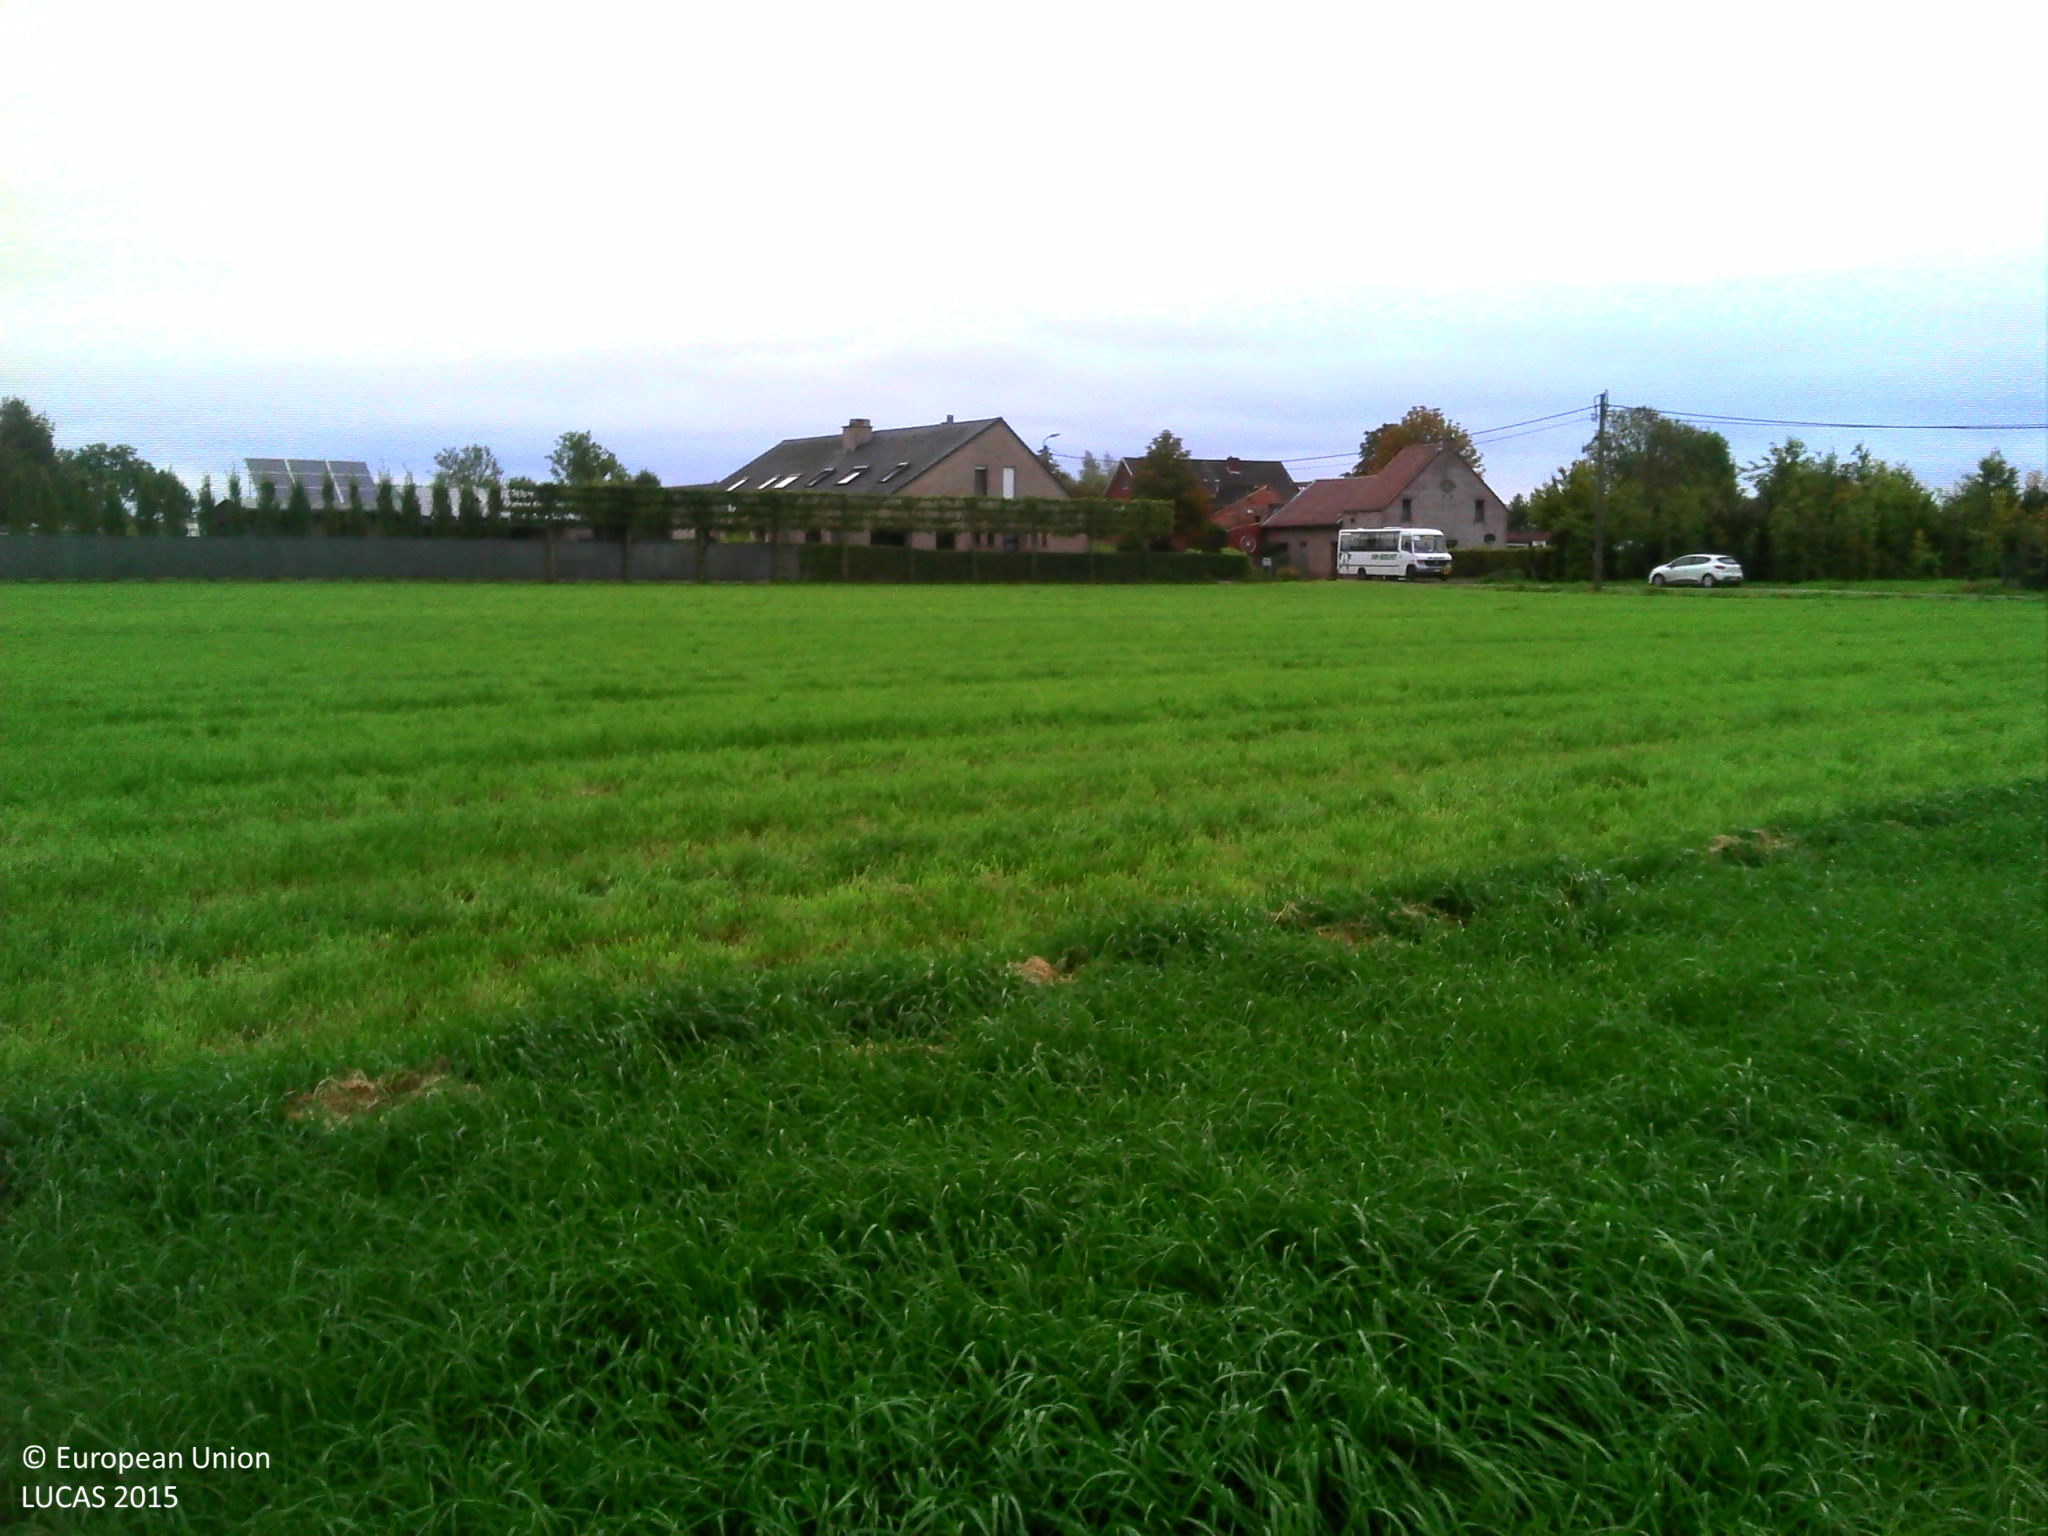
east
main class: Cropland
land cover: Temporary grasslands
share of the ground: > 75 %
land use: Agriculture (excluding fallow land and kitchen gardens)
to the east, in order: Temporary grasslands; Artificial constructions in urban areas; Temporary grasslands; Artificial constructions in urban areas; Ditches and canals; Temporary grasslands
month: October
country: BE
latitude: 51.0382
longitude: 4.7911
